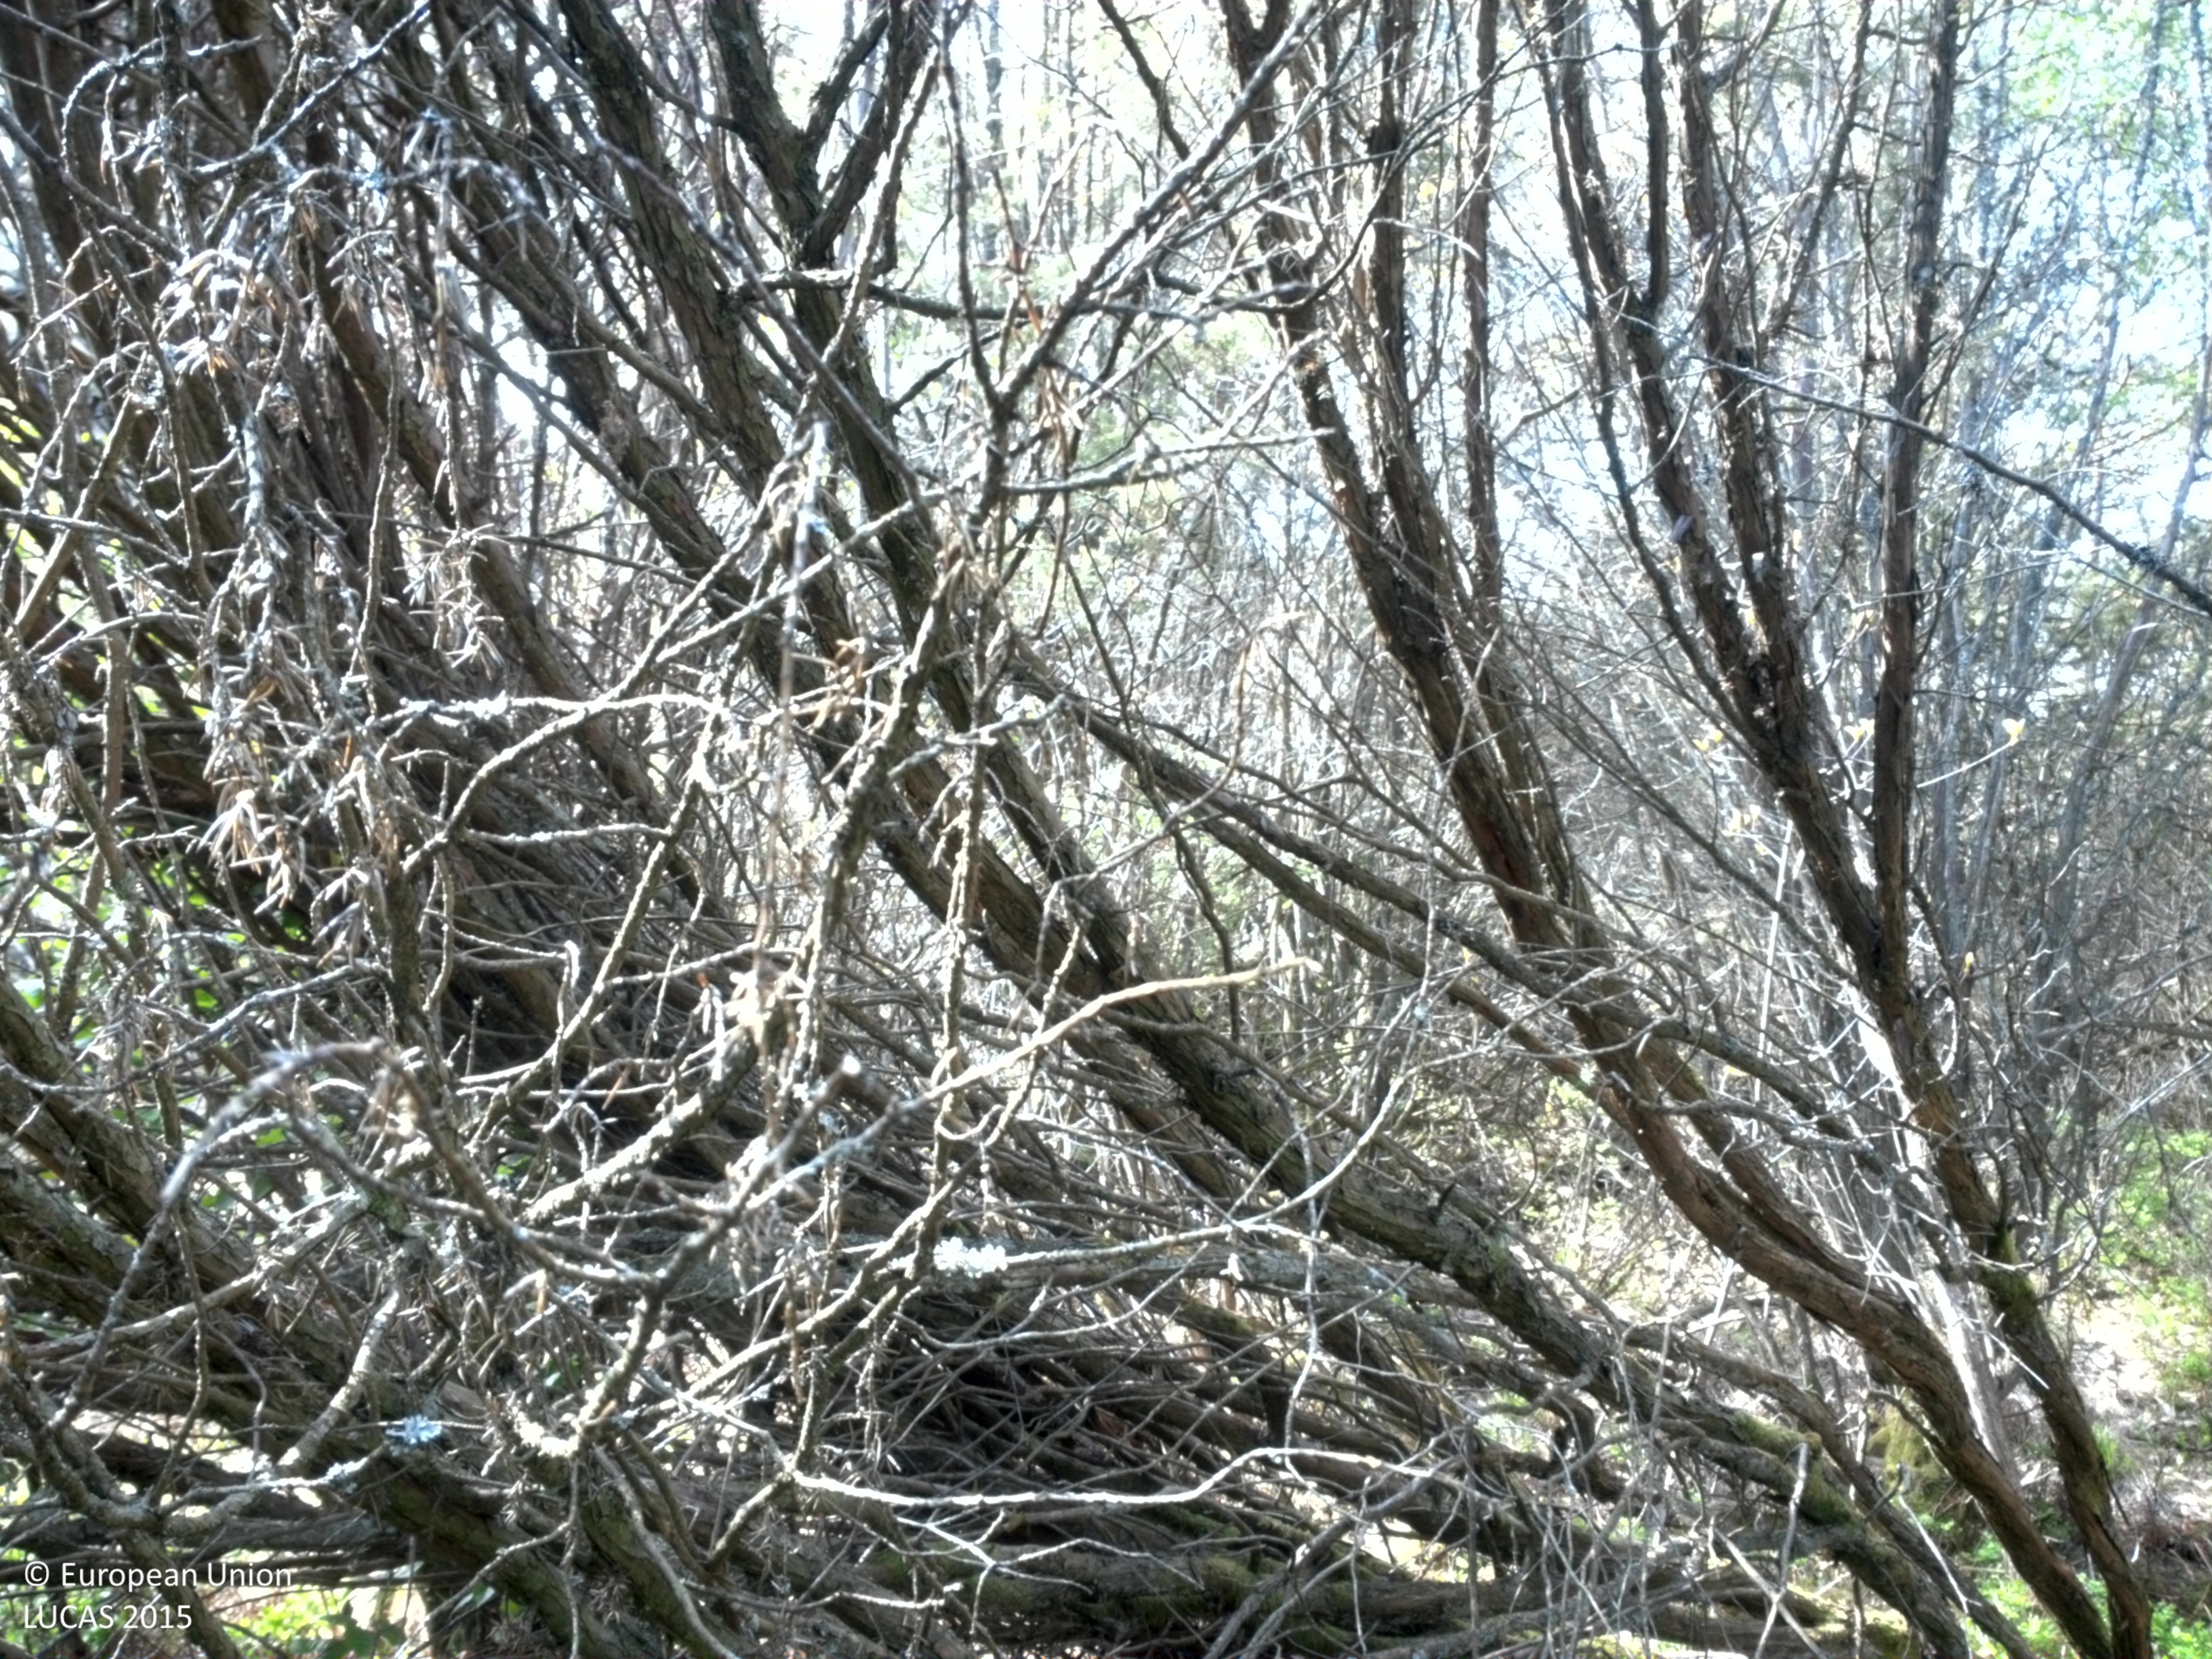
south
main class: Woodland
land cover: Pine dominated mixed woodland
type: boreal forest
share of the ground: 50 - 75 %
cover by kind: coniferous forest trees 50 %, broadleaved forest trees 25 %, shrubs 15 %, herbaceous plants 10 %
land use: Amenities, museums, leisure
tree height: > 5 m
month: May
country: SE
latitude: 57.6116
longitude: 11.9552
